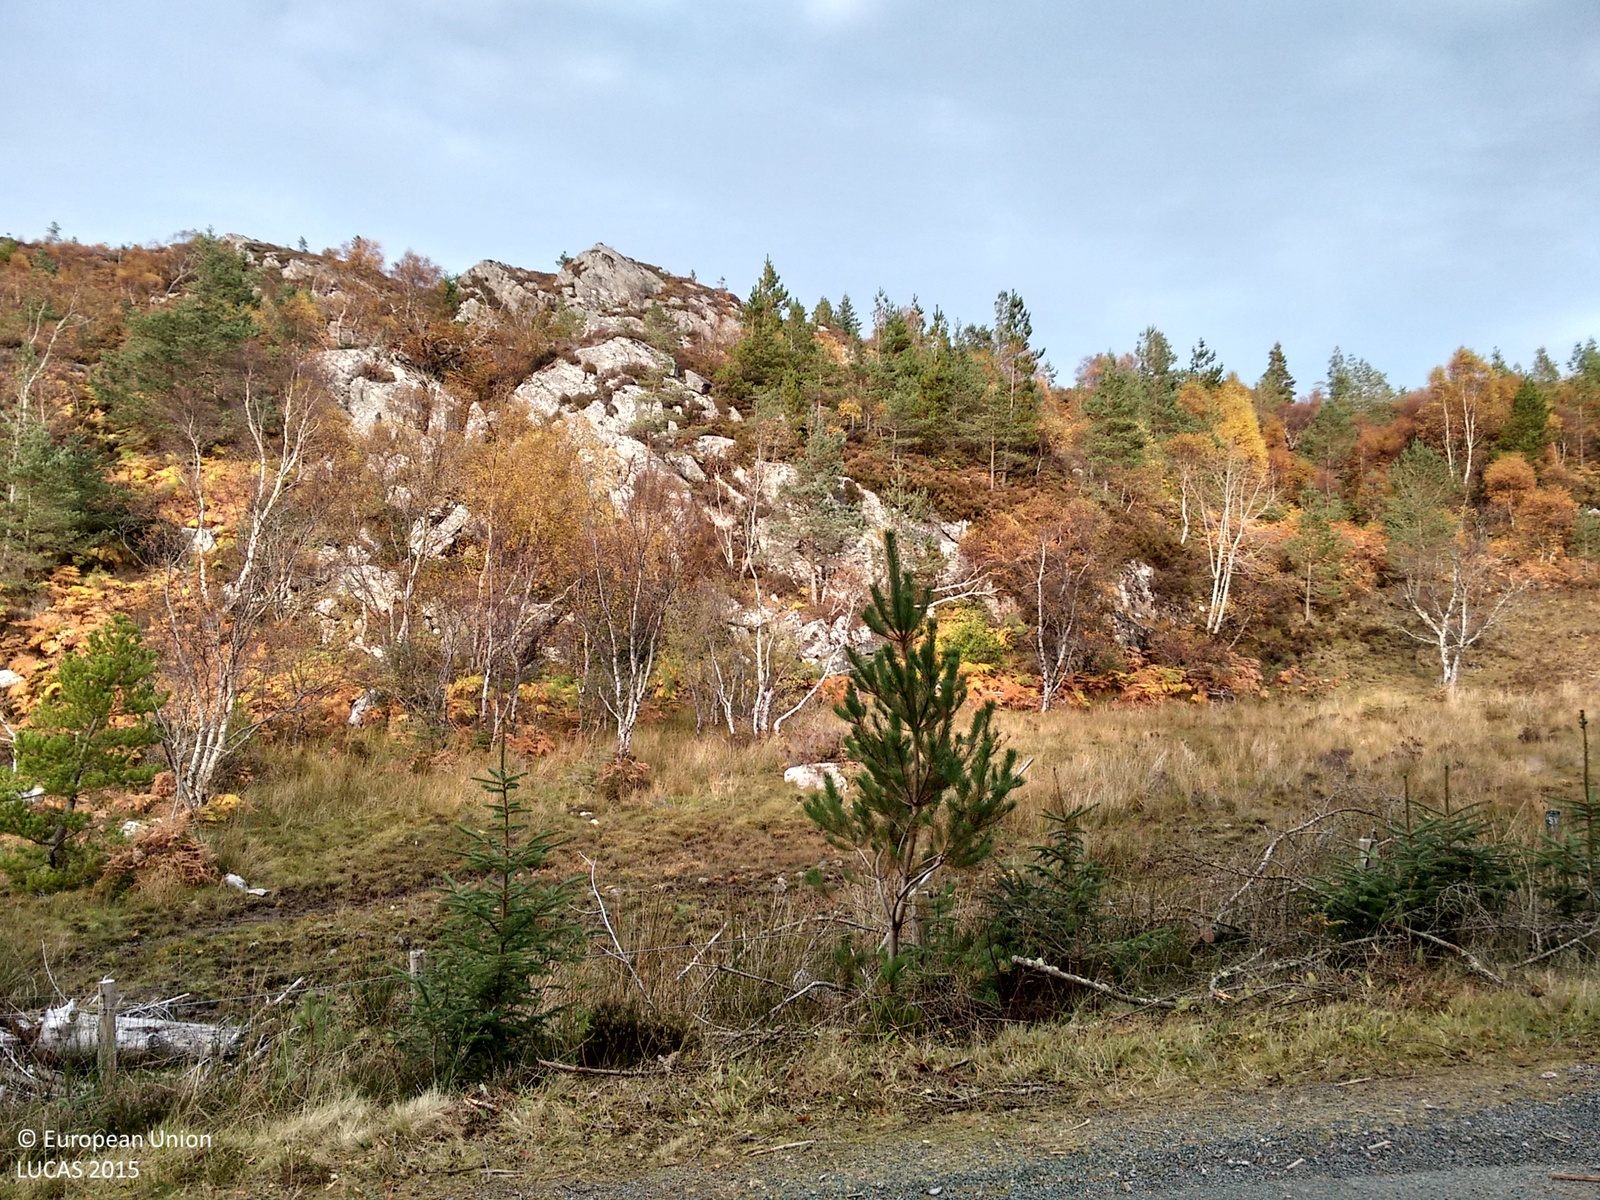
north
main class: Woodland
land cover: Spruce dominated coniferous woodland
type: exotic forest
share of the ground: > 75 %
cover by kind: coniferous forest trees 80 %, shrubs 10 %, herbaceous plants 10 %
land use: Forestry
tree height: > 5 m
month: November
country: GB
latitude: 57.3306
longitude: -5.6506
